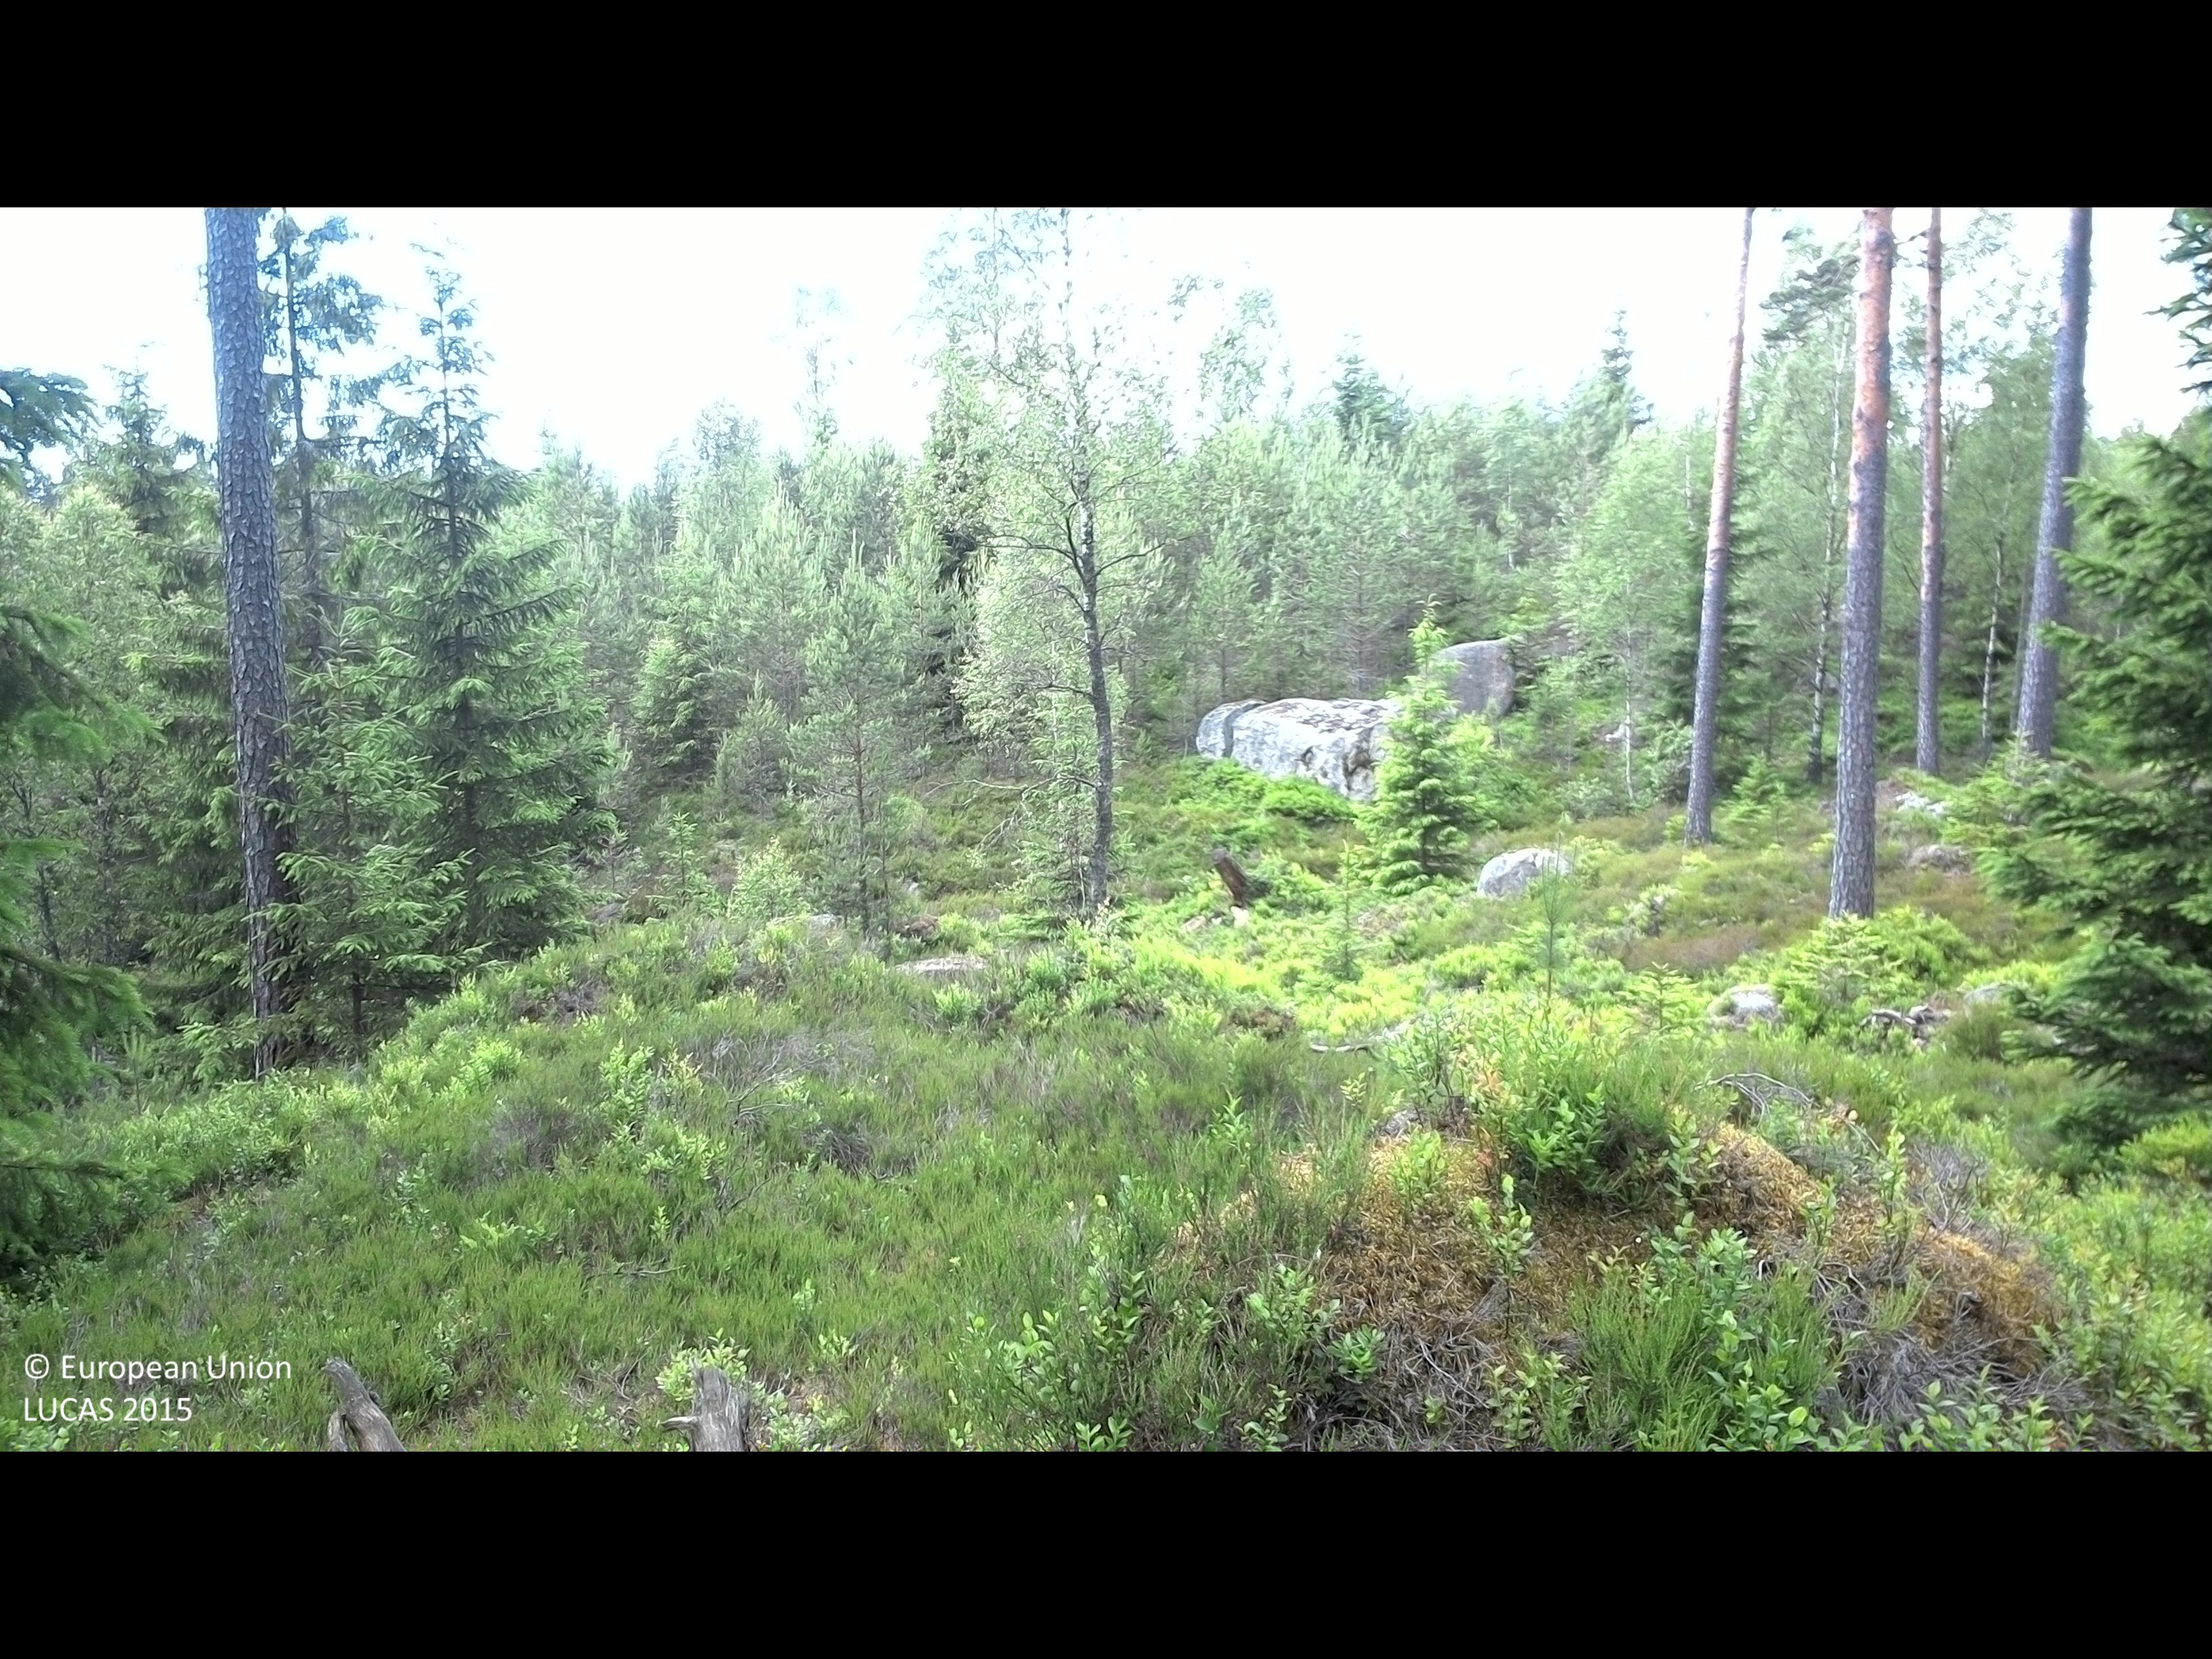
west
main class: Woodland
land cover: Pine dominated coniferous woodland
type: boreal forest
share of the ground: 50 - 75 %
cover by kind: coniferous forest trees 50 %, shrubs 35 %, lichens and mosses 15 %
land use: Forestry
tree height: > 5 m
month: July
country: SE
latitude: 56.4055
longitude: 15.2329
